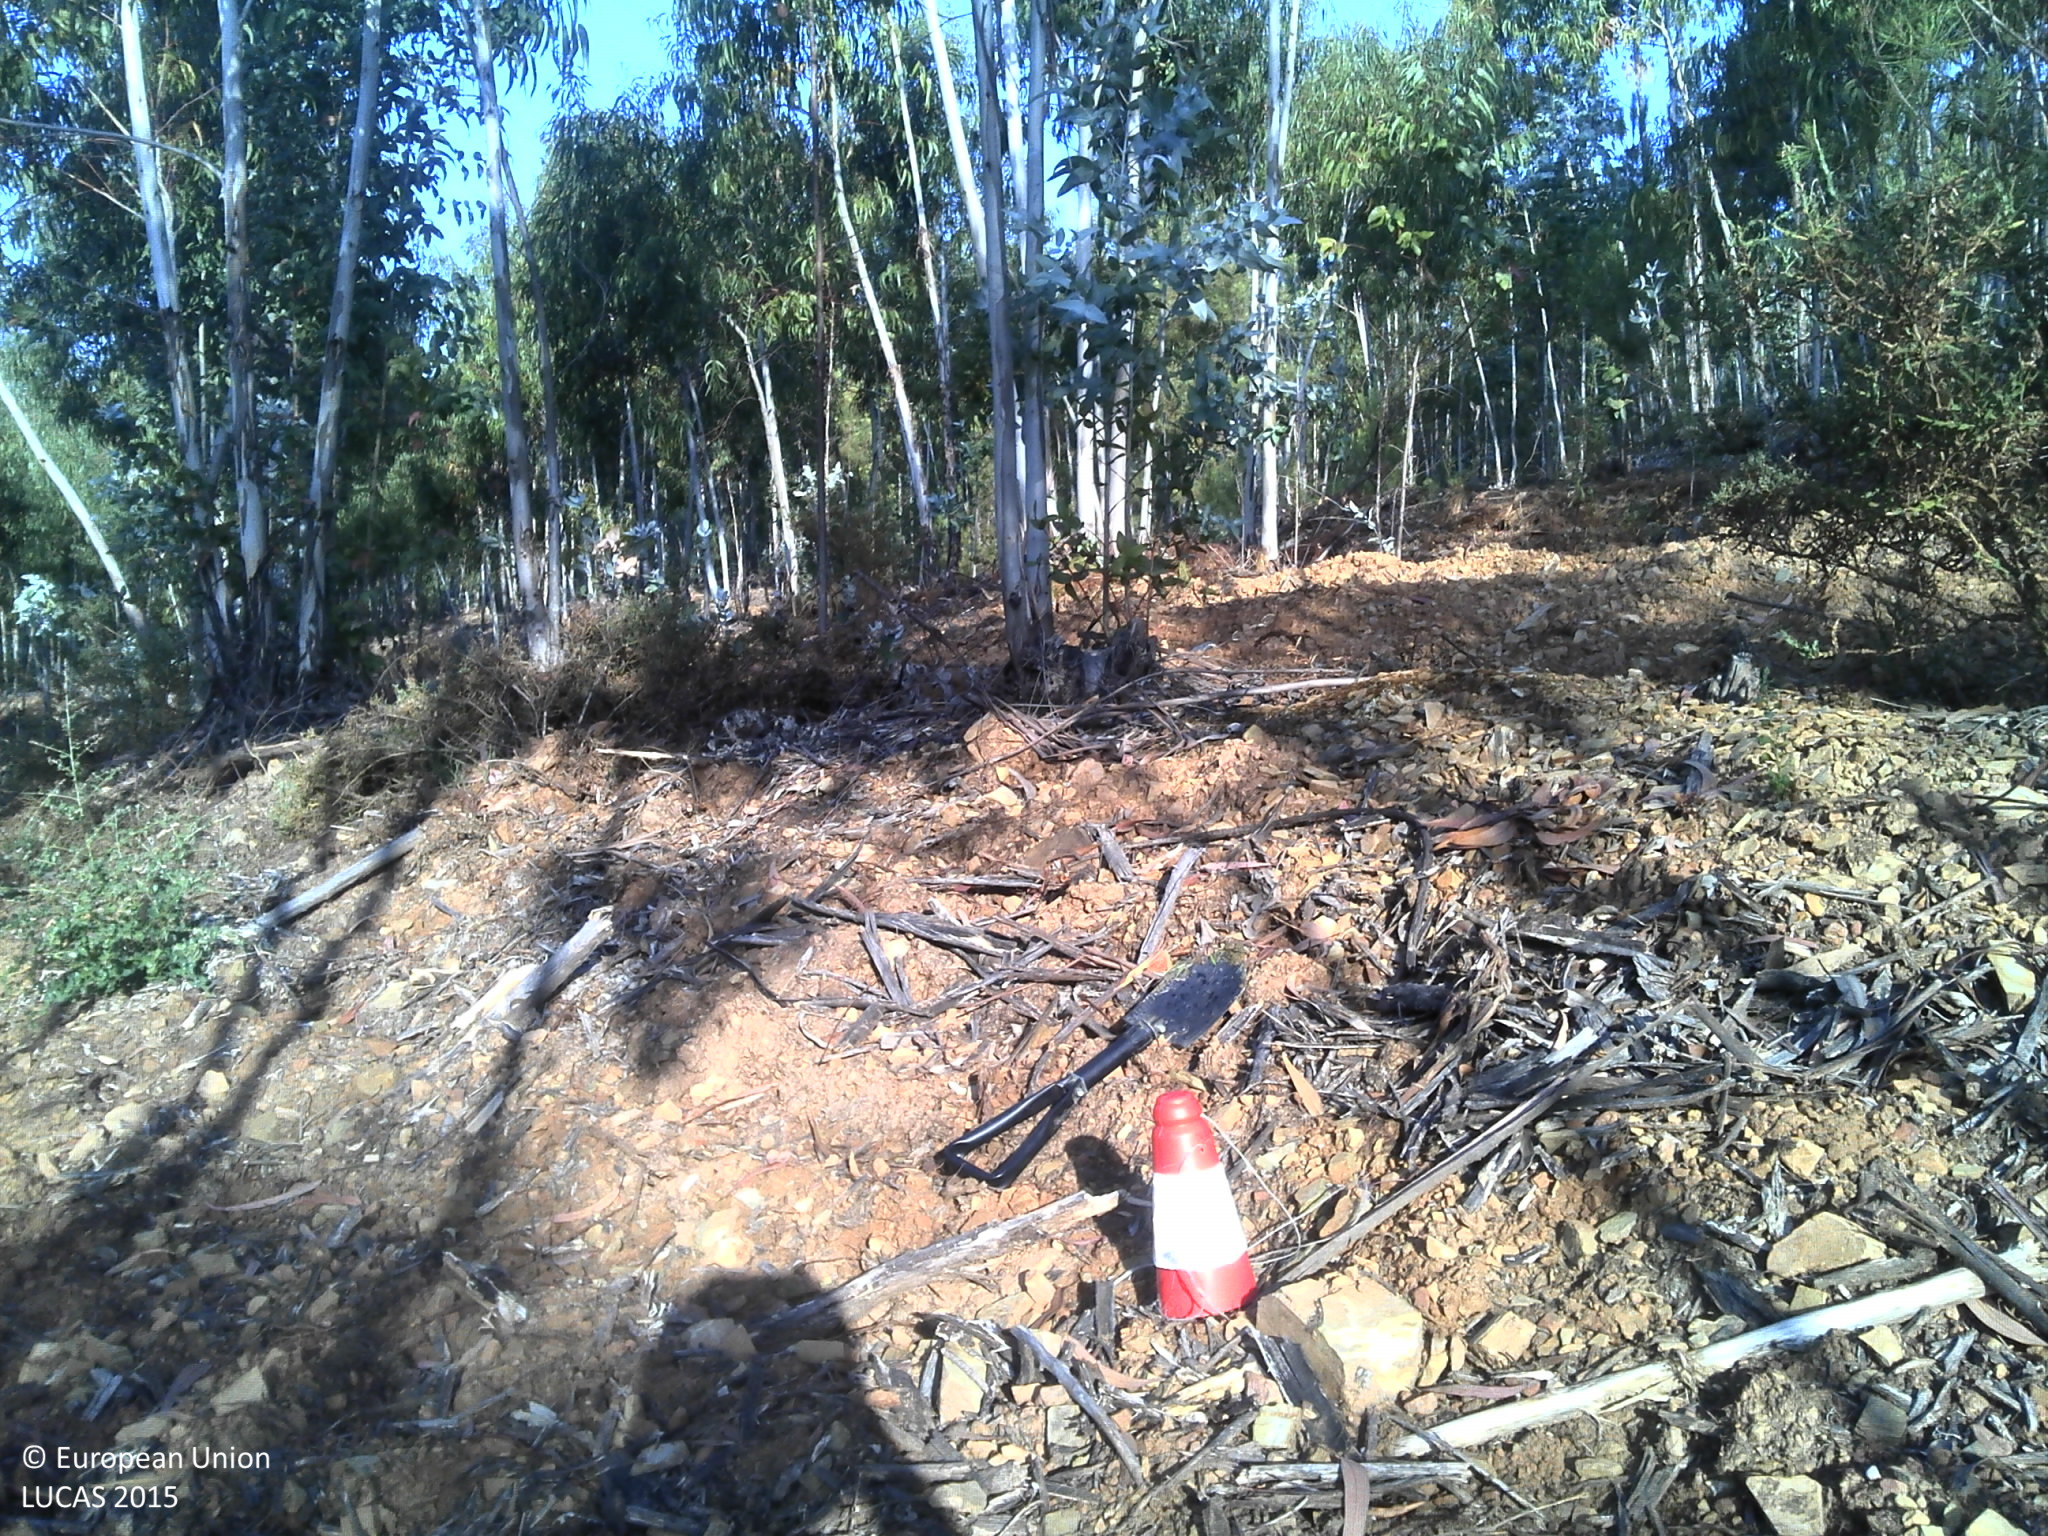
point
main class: Woodland
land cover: Broadleaved woodland
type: exotic forest
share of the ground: 25 - 50 %
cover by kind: broadleaved forest trees 50 %, unconsolidated bare surface 40 %, shrubs 10 %
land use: Forestry
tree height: > 5 m
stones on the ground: 10 - 25 %
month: June
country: PT
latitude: 40.1740
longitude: -7.3043
